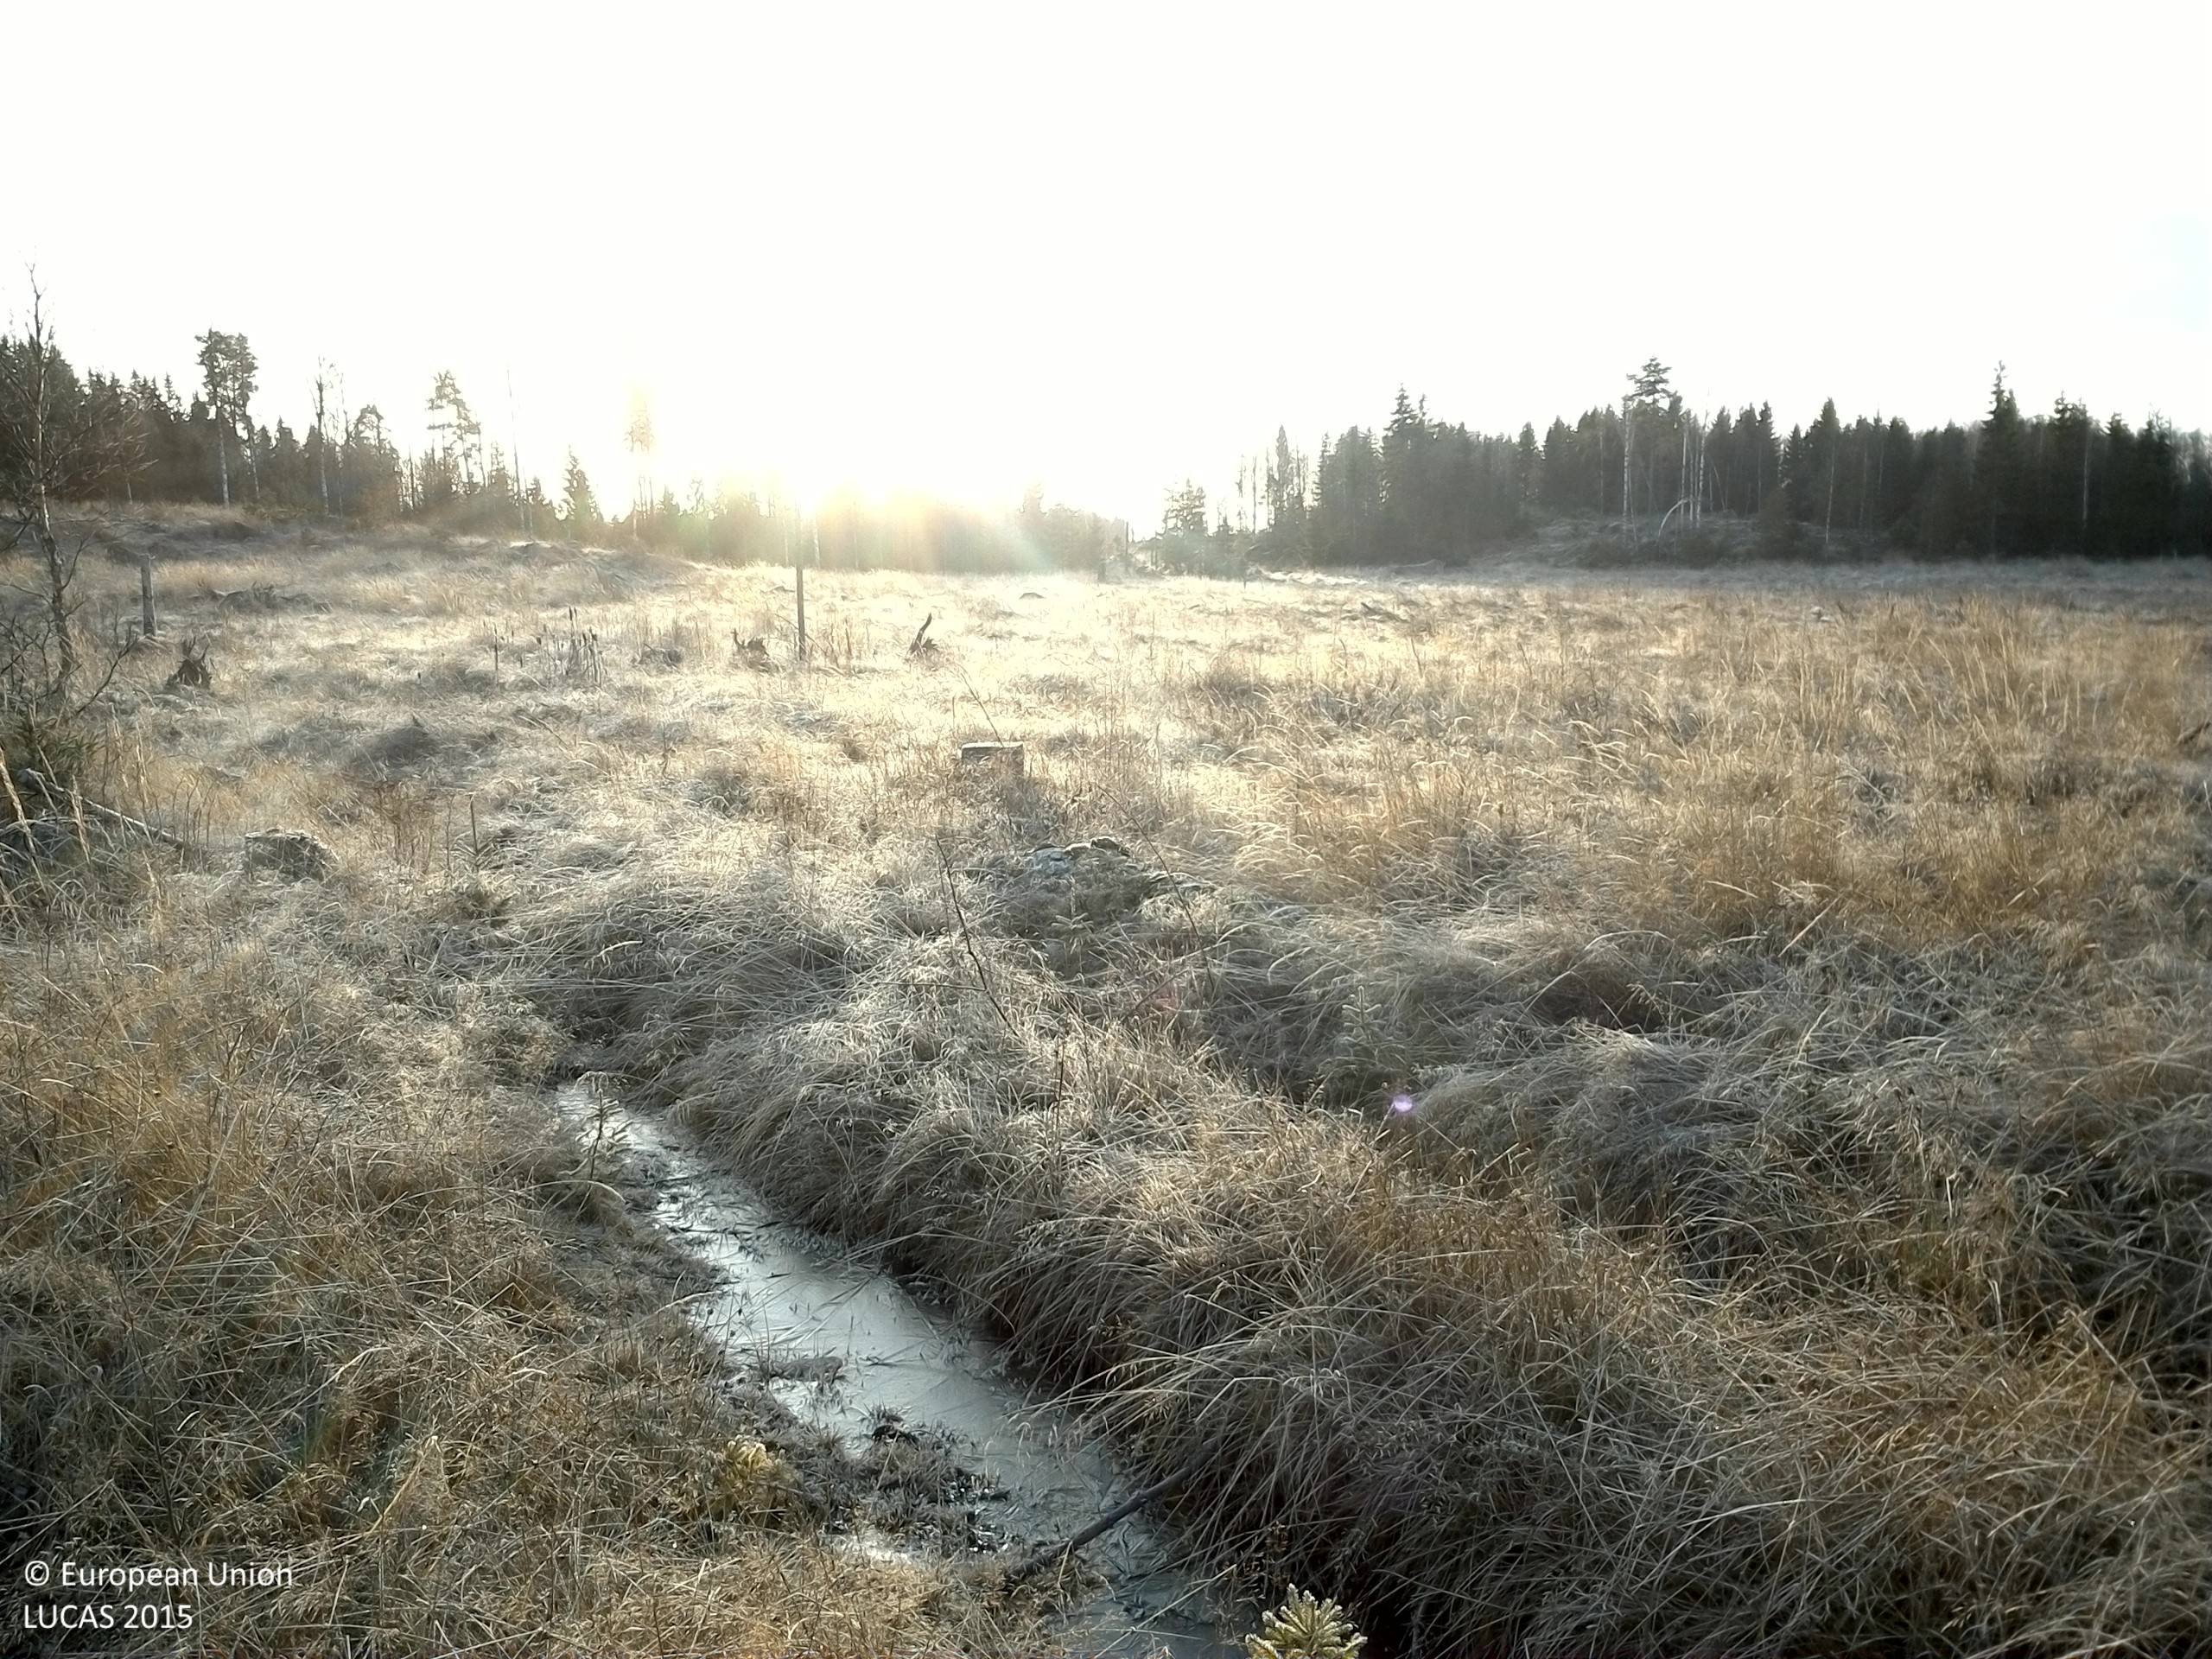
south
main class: Grassland
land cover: Grassland with sparse tree/shrub cover
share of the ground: > 75 %
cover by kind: herbaceous plants 85 %, coniferous forest trees 5 %, shrubs 5 %, consolidated bare surface 5 %
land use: Forestry
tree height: < 5 m
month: December
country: SE
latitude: 59.7503
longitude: 16.7012
